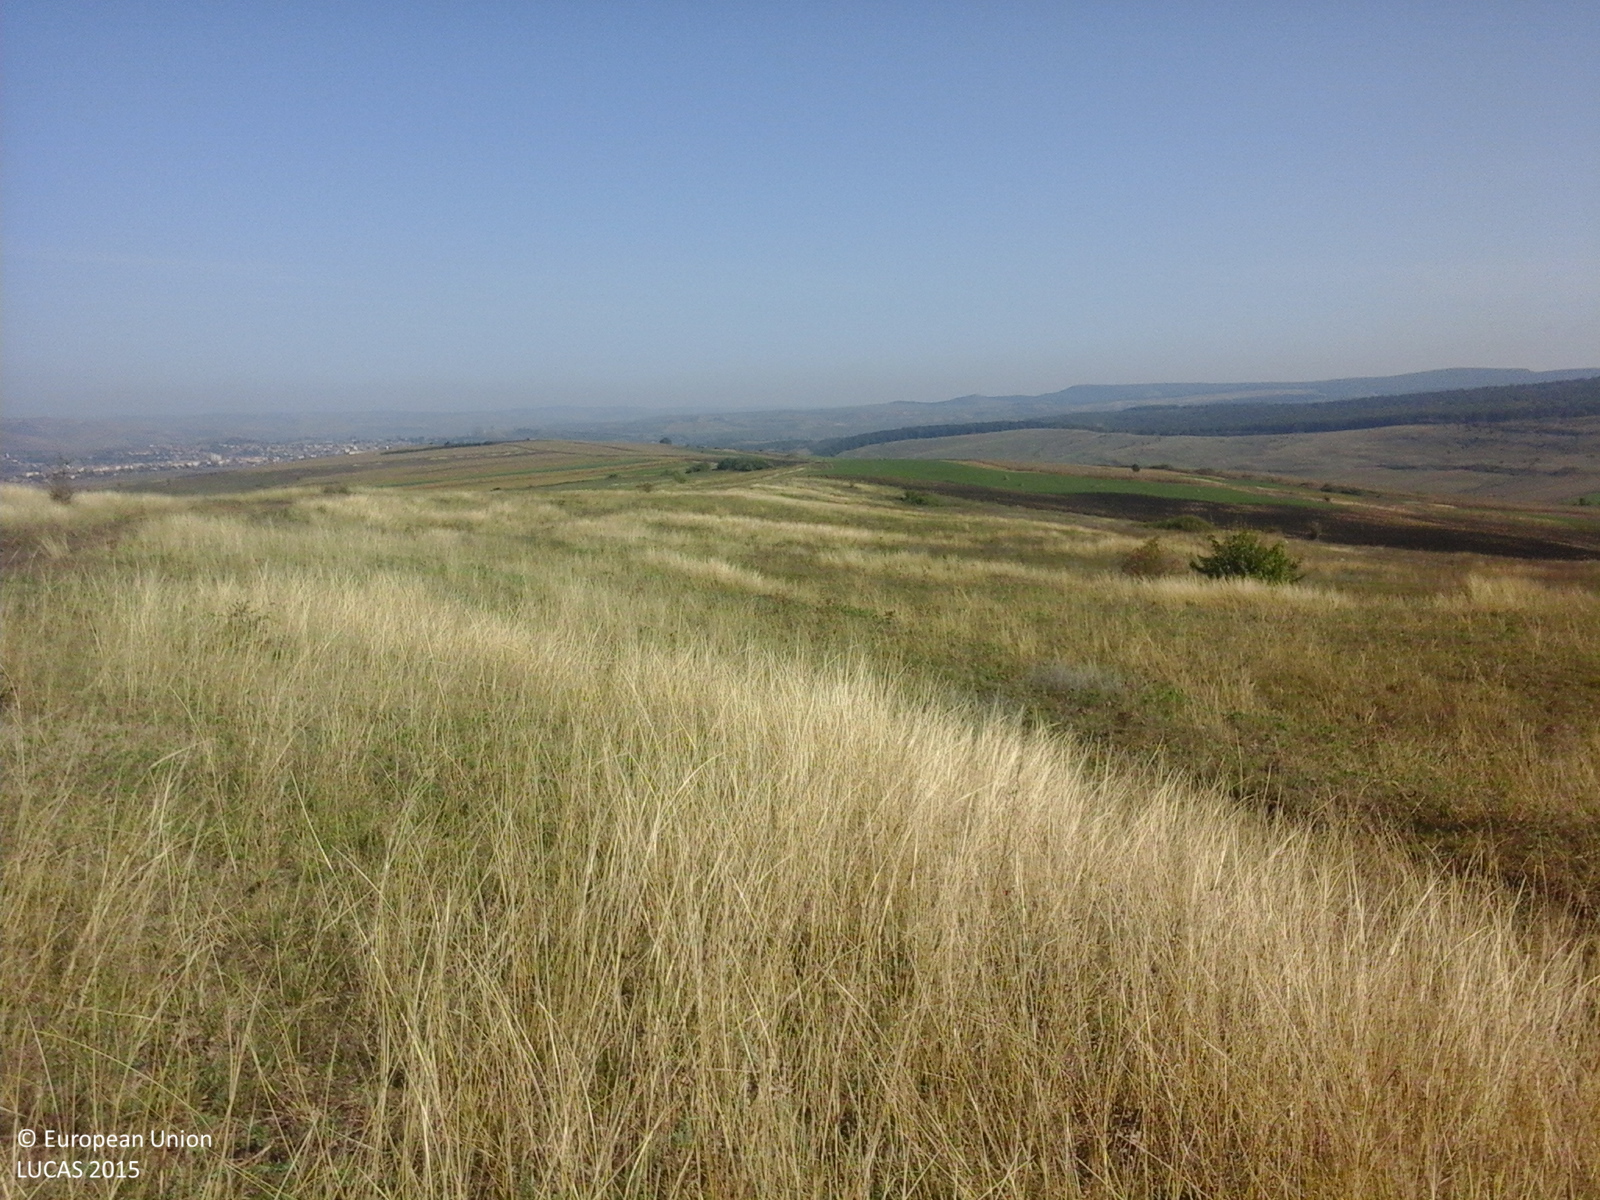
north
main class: Grassland
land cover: Grassland without tree/shrub cover
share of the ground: > 75 %
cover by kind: herbaceous plants 100 %
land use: Agriculture (excluding fallow land and kitchen gardens)
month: October
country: RO
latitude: 46.1346
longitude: 23.8833
